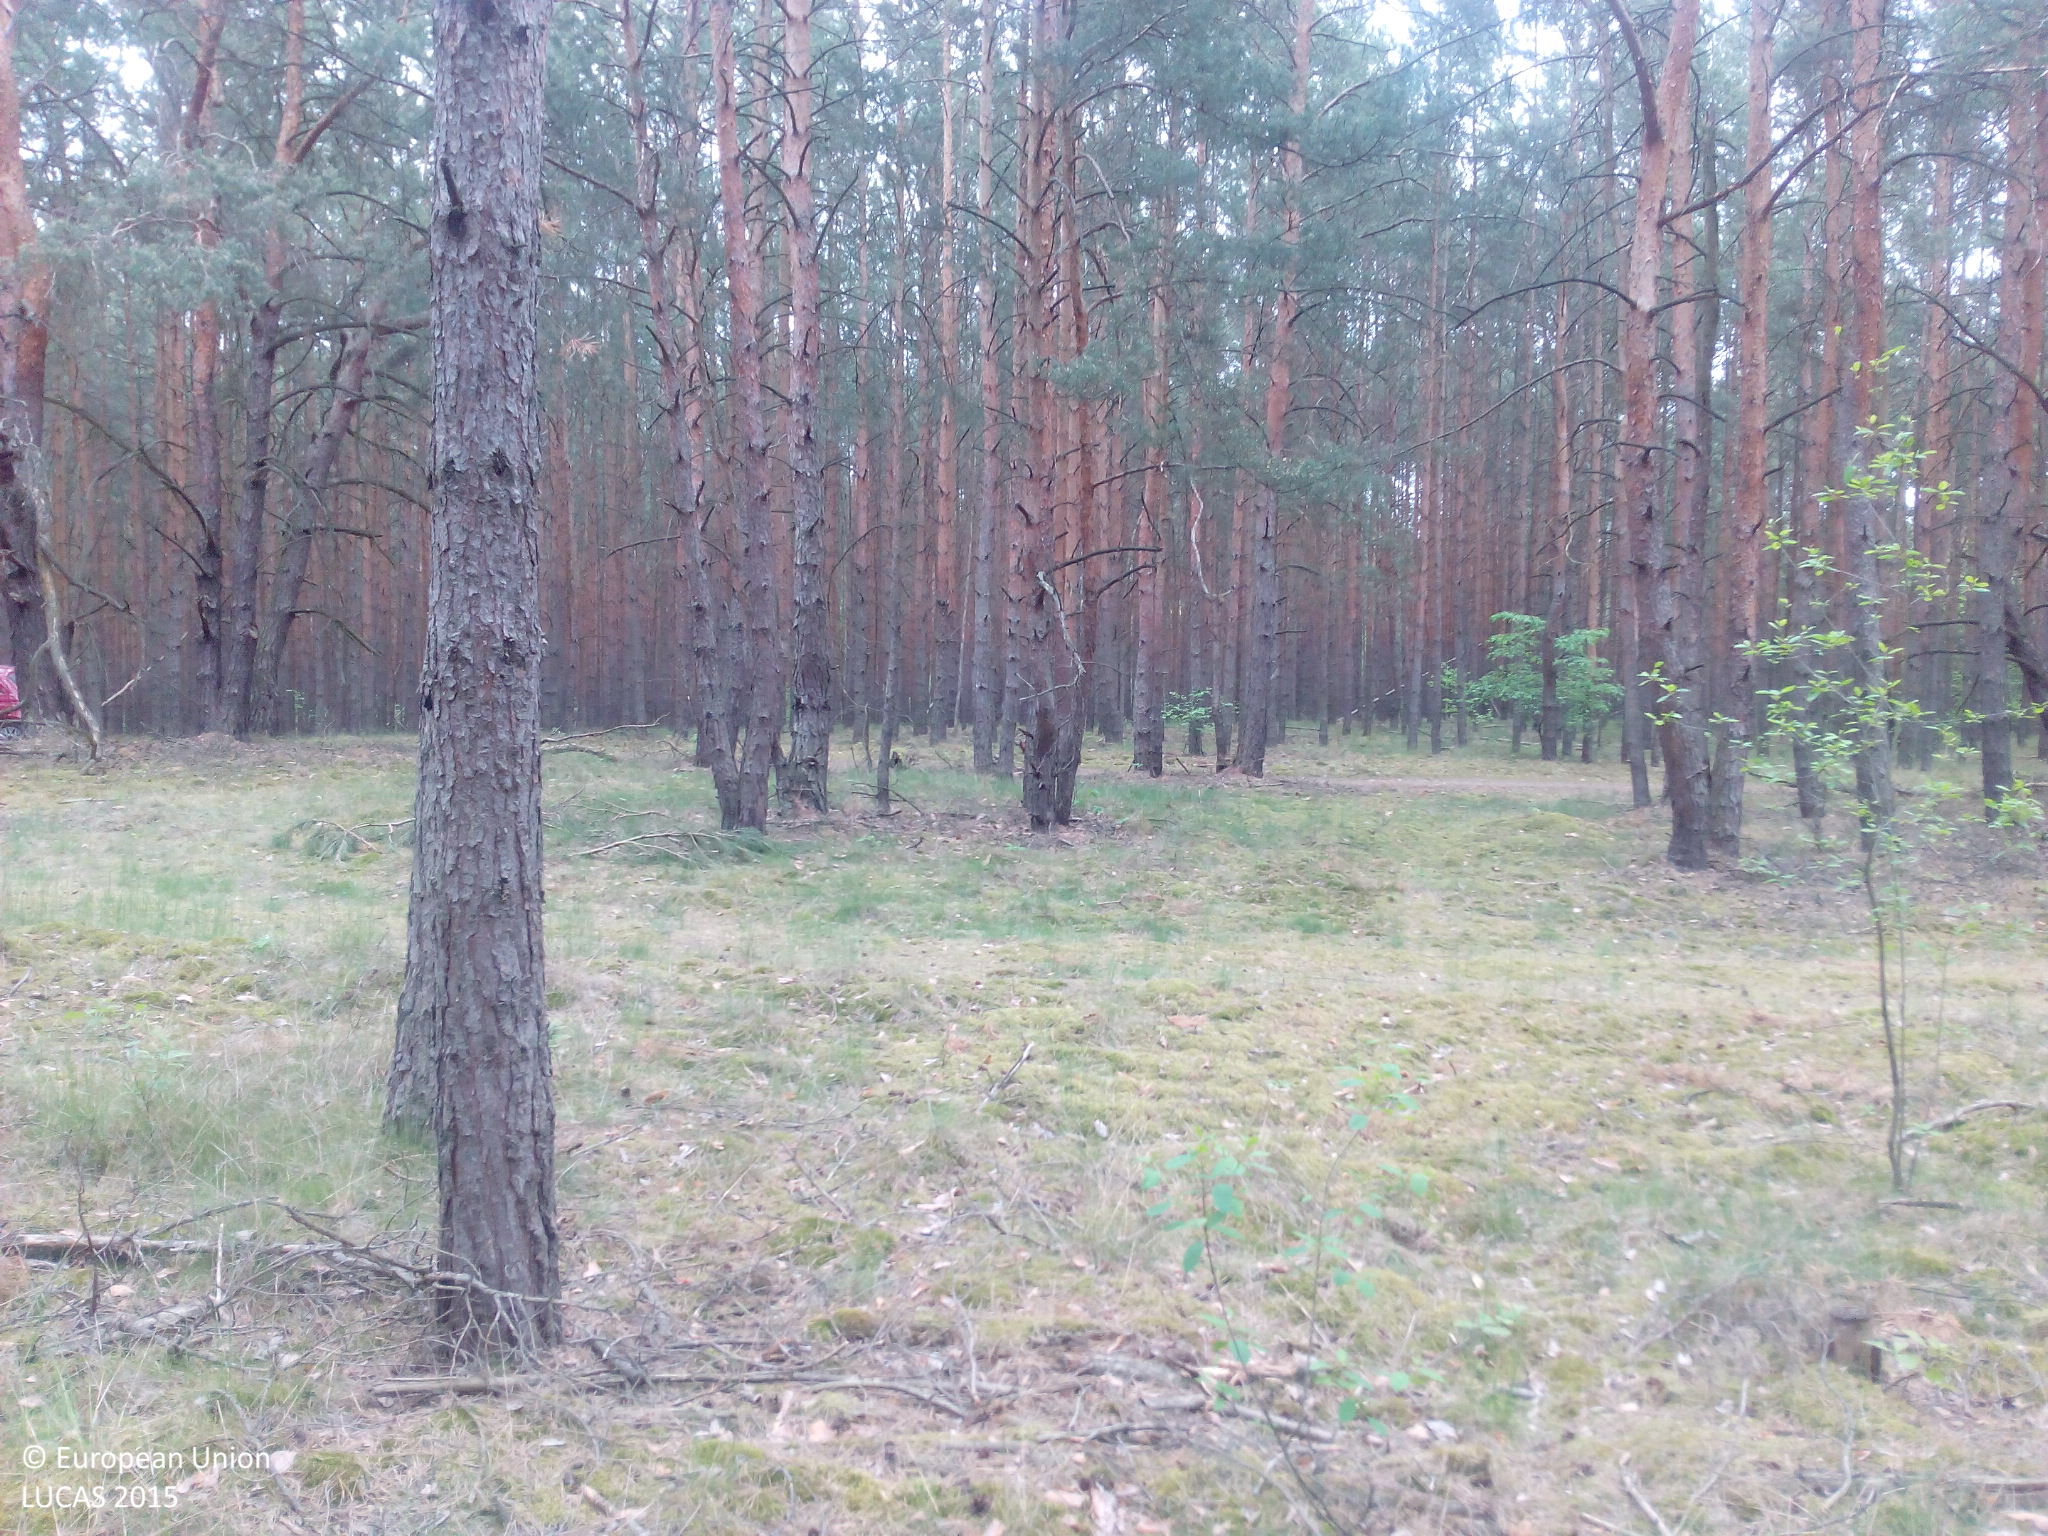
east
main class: Woodland
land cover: Pine dominated coniferous woodland
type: hemiboreal forest and nemoral coniferous forest and mixed broadleaved-coniferous forest
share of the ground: > 75 %
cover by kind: coniferous forest trees 75 %, lichens and mosses 20 %, herbaceous plants 5 %
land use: Forestry
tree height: > 5 m
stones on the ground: < 10 %
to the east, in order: Pine dominated coniferous woodland; Tracks; Pine dominated coniferous woodland; Tracks; Pine dominated coniferous woodland; Tracks; Pine dominated coniferous woodland; Grassland without tree/shrub cover
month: May
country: DE
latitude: 52.2271
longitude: 13.1769
